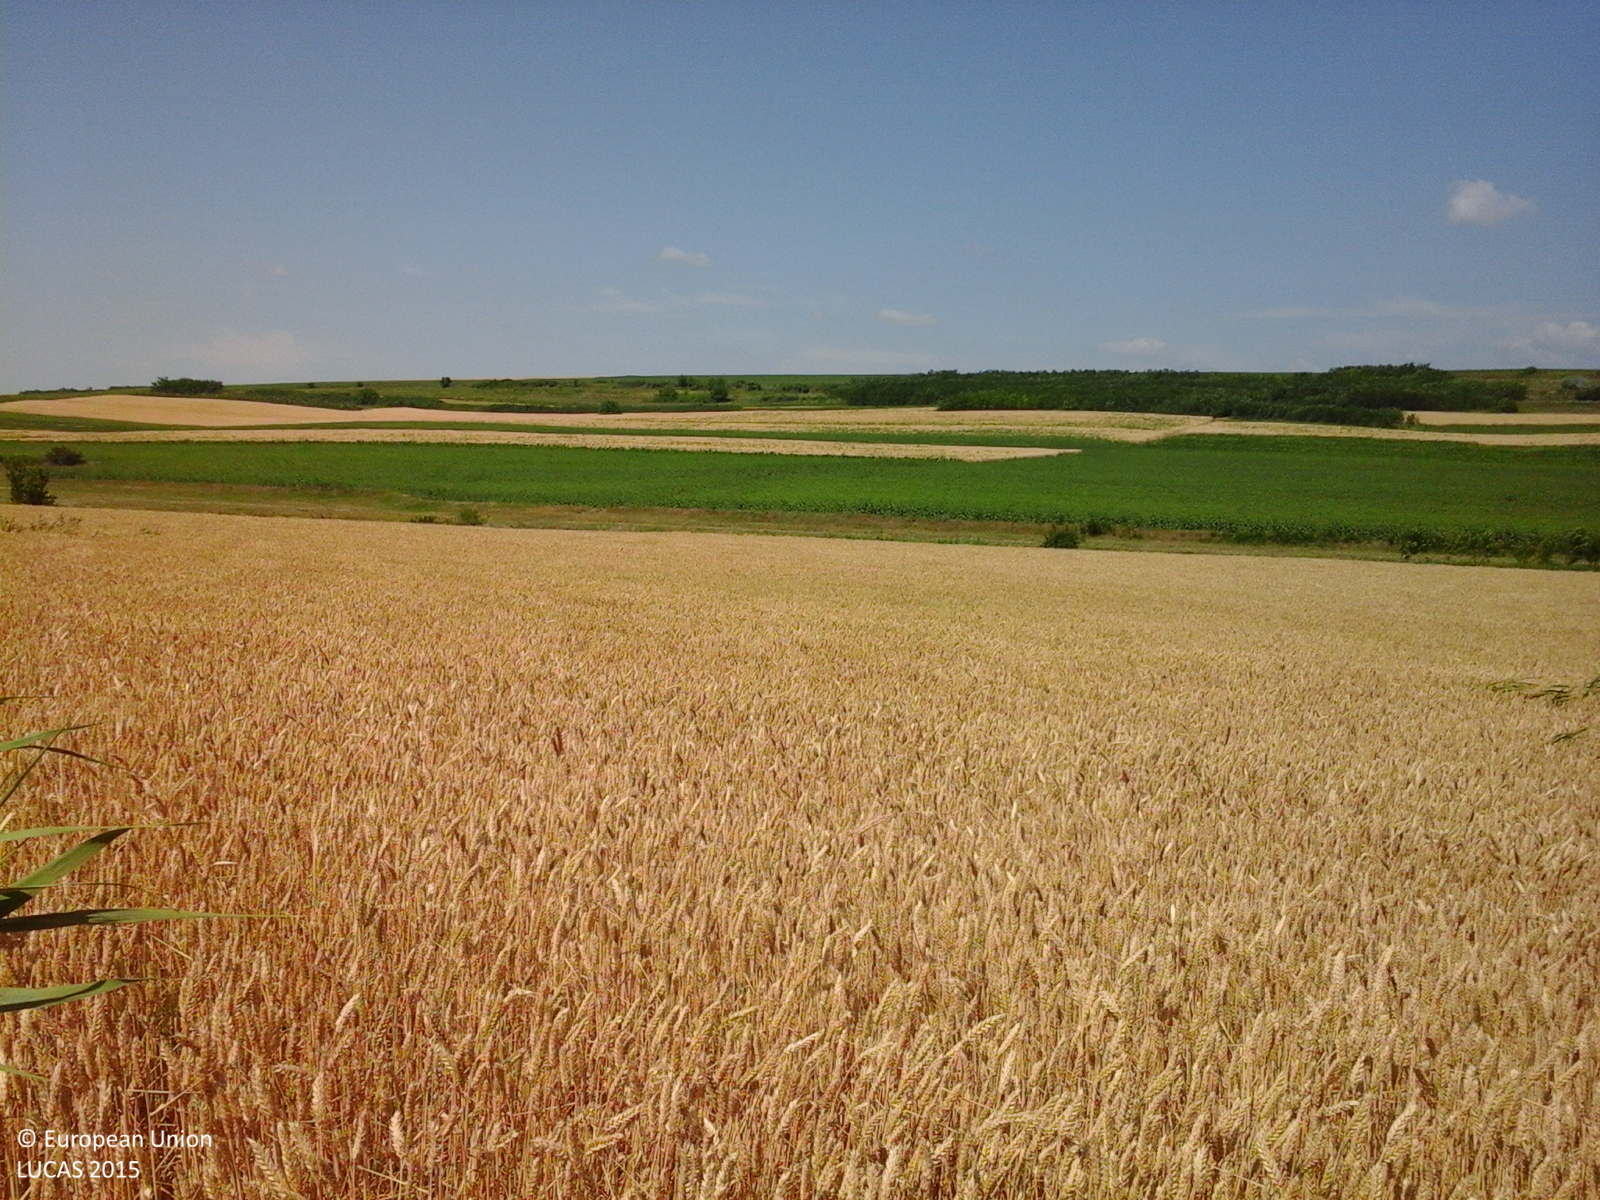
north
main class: Cropland
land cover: Common wheat
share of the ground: > 75 %
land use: Agriculture (excluding fallow land and kitchen gardens)
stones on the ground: < 10 %
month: June
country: RO
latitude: 46.8620
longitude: 28.0630
